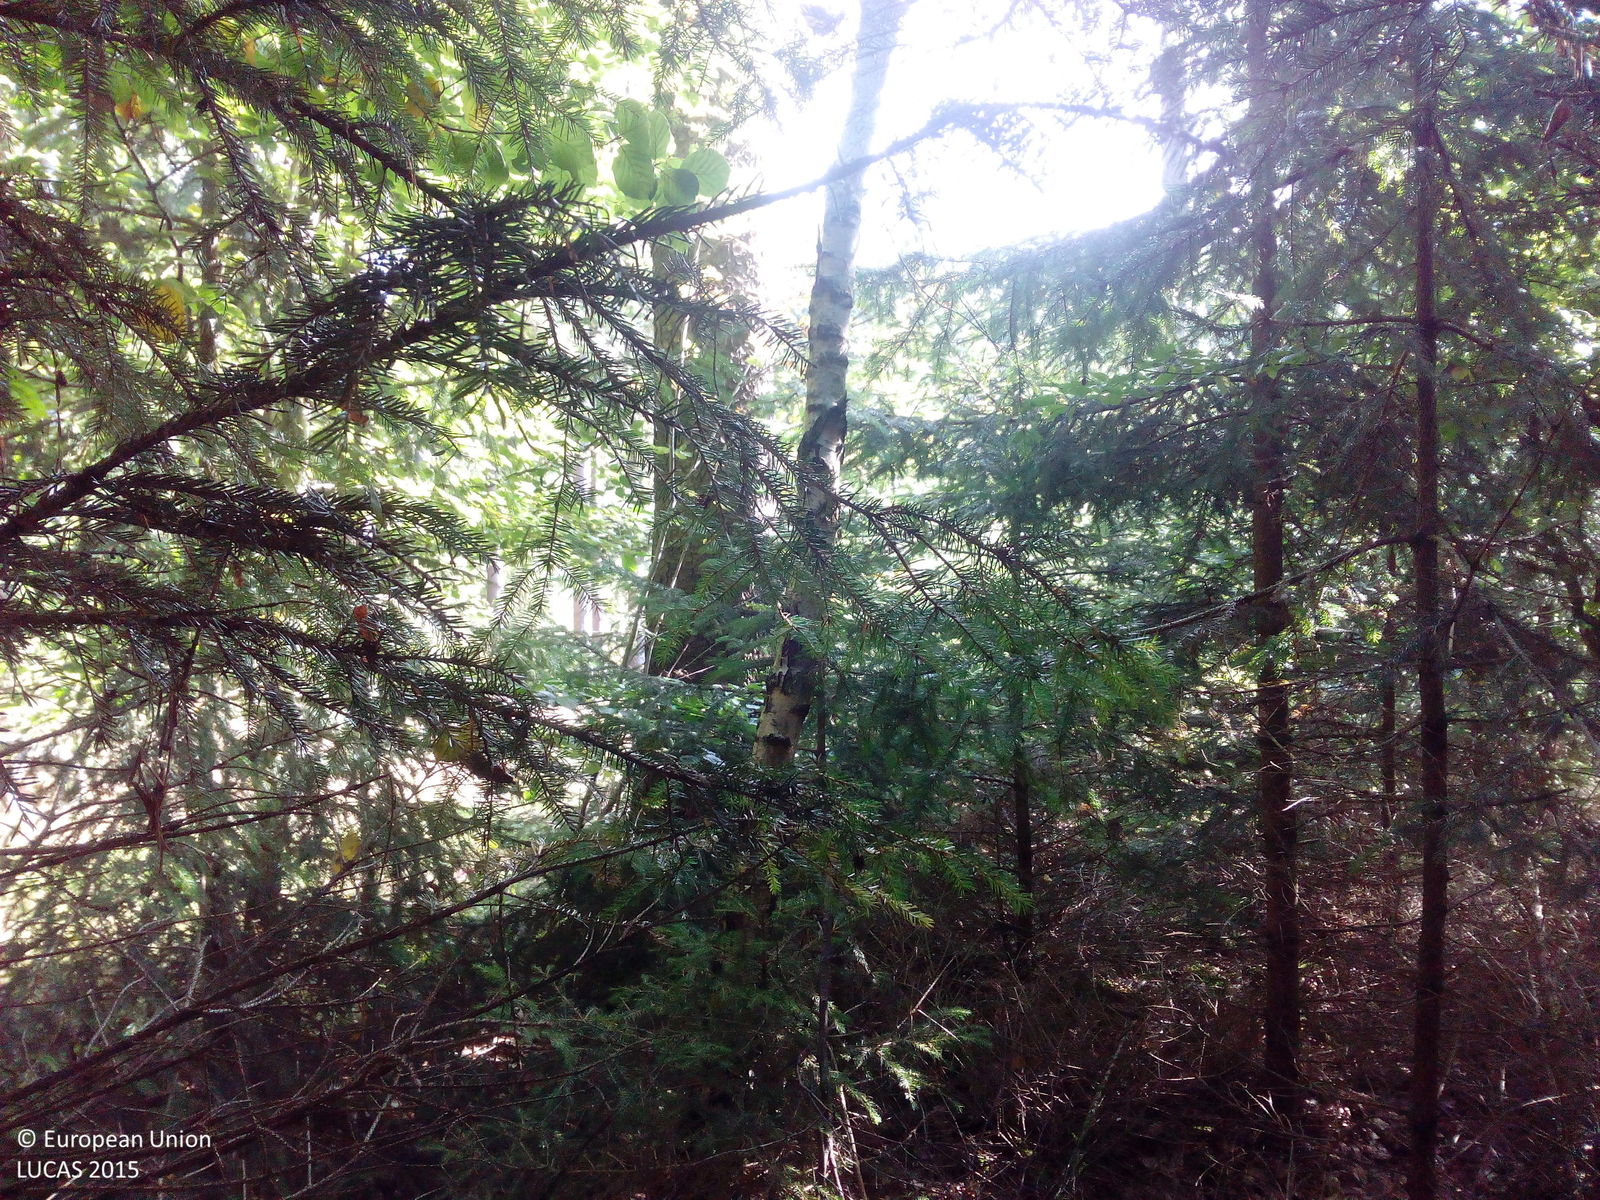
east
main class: Woodland
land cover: Spruce dominated coniferous woodland
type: hemiboreal forest and nemoral coniferous forest and mixed broadleaved-coniferous forest
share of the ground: > 75 %
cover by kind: coniferous forest trees 90 %, broadleaved forest trees 10 %
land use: Forestry
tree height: > 5 m
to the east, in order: Spruce dominated coniferous woodland; Tracks; Spruce dominated coniferous woodland; Shruby margins; Tracks; Spontaneously vegetated surfaces; Spruce dominated coniferous woodland; Spruce dominated mixed woodland; Spruce dominated coniferous woodland
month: September
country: DE
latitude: 51.7837
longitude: 9.6377
